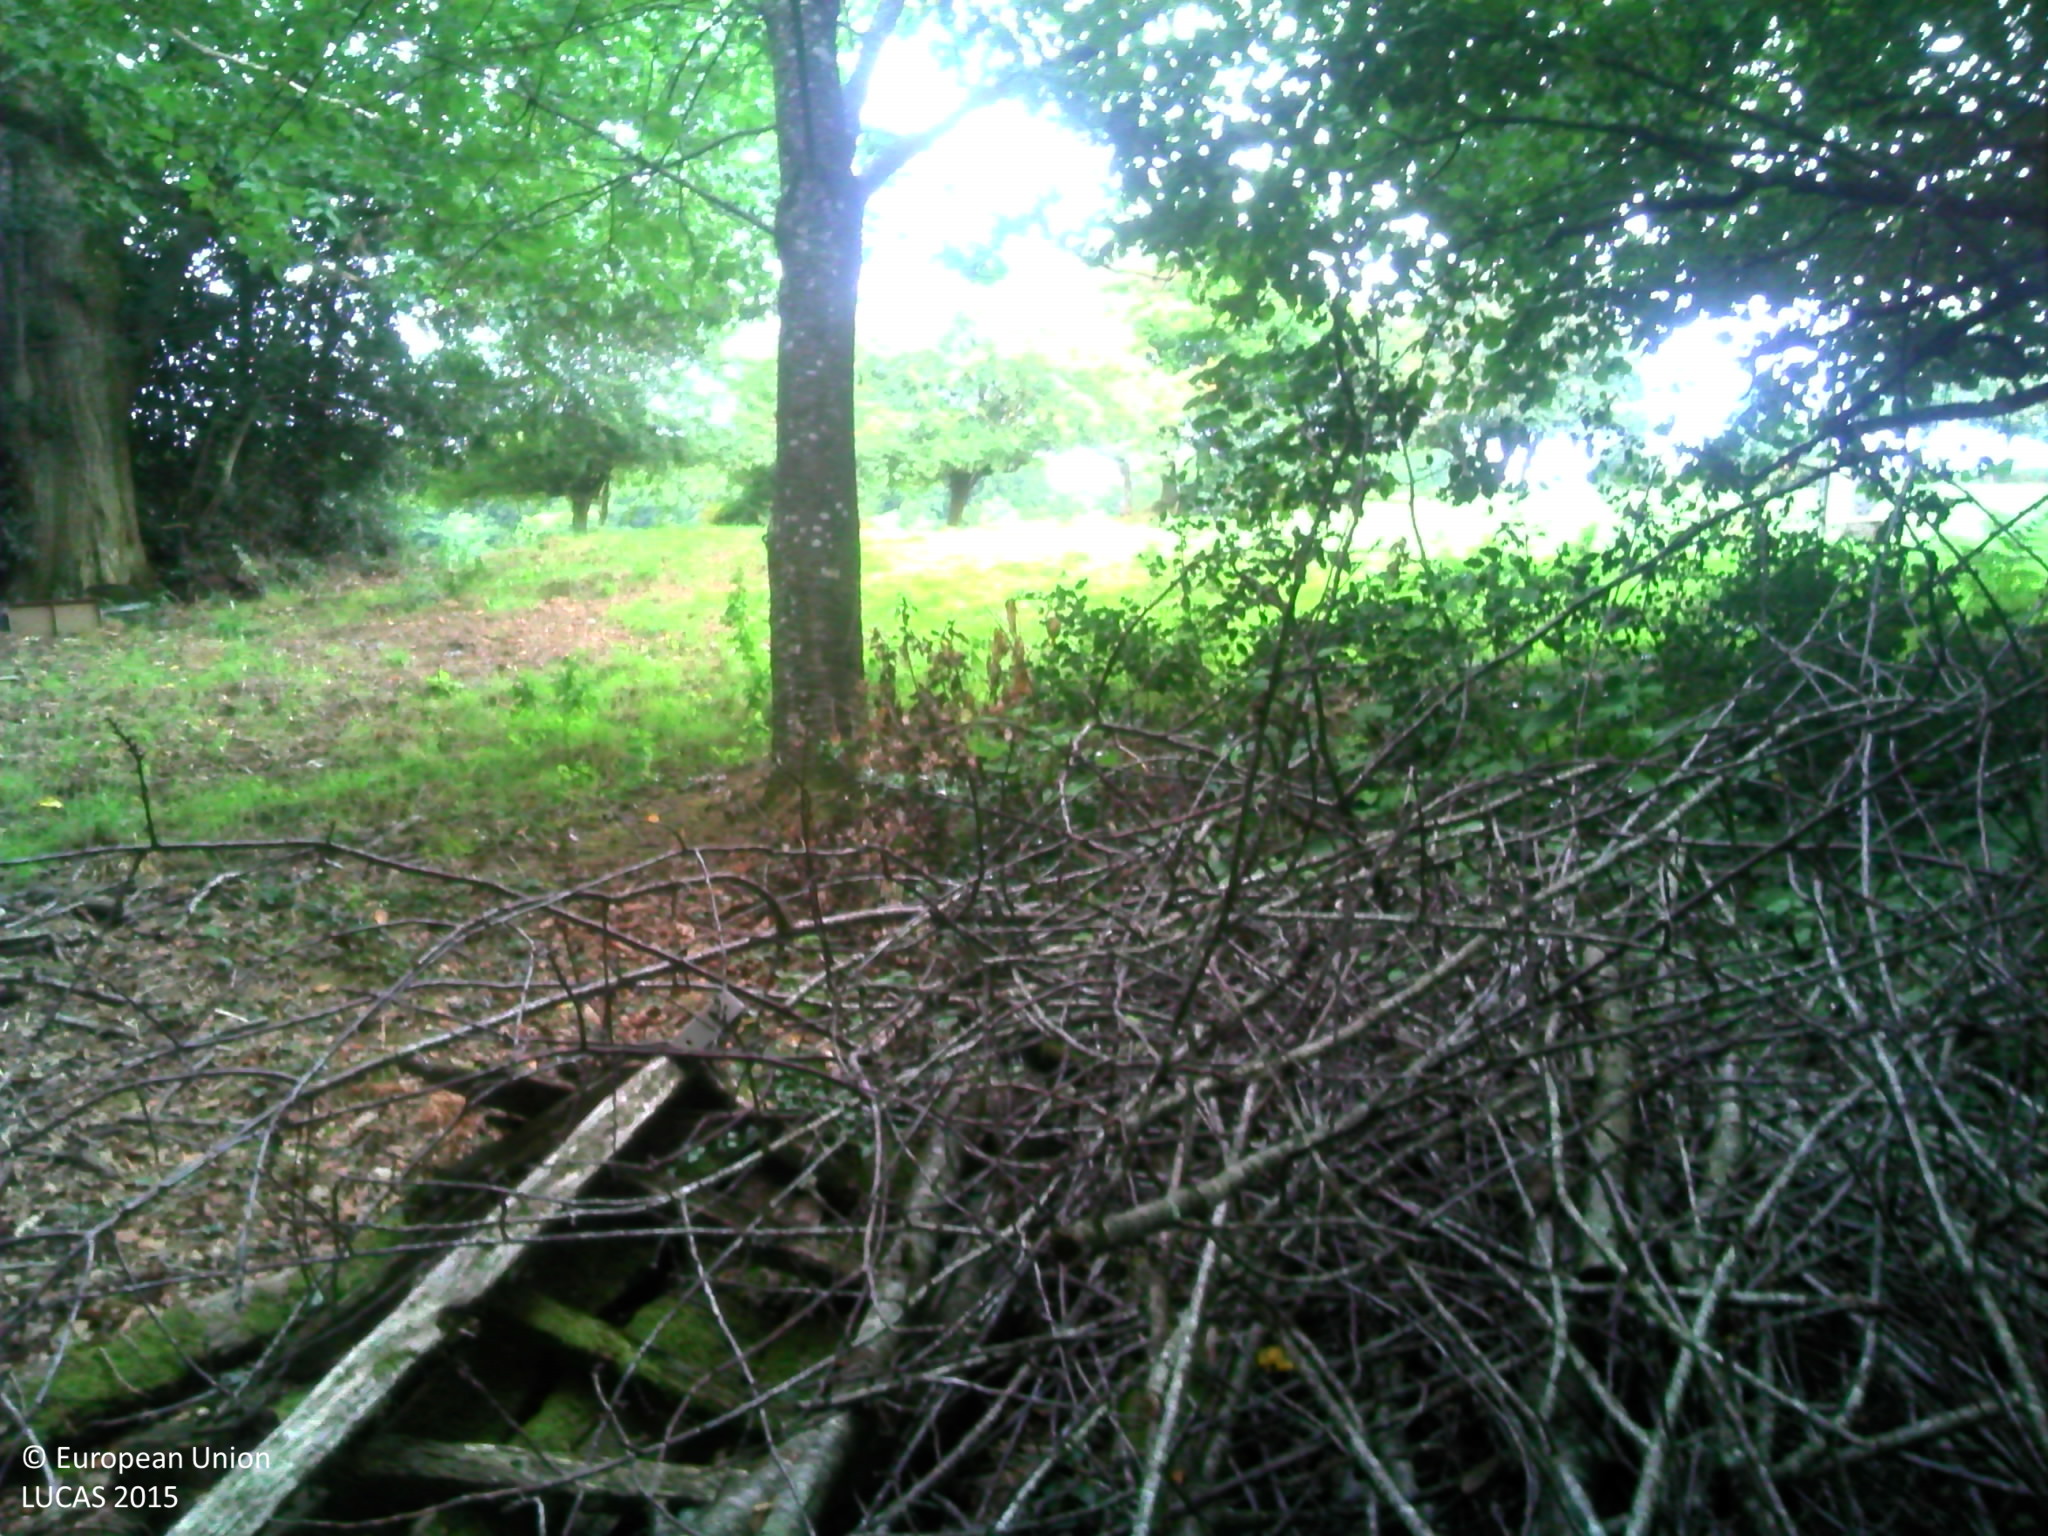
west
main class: Woodland
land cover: Broadleaved woodland
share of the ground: > 75 %
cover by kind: broadleaved forest trees 75 %, herbaceous plants 10 %, lichens and mosses 10 %, shrubs 5 %
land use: Forestry
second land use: Agriculture (excluding fallow land and kitchen gardens)
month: August
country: FR
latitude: 46.3742
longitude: 2.2069
